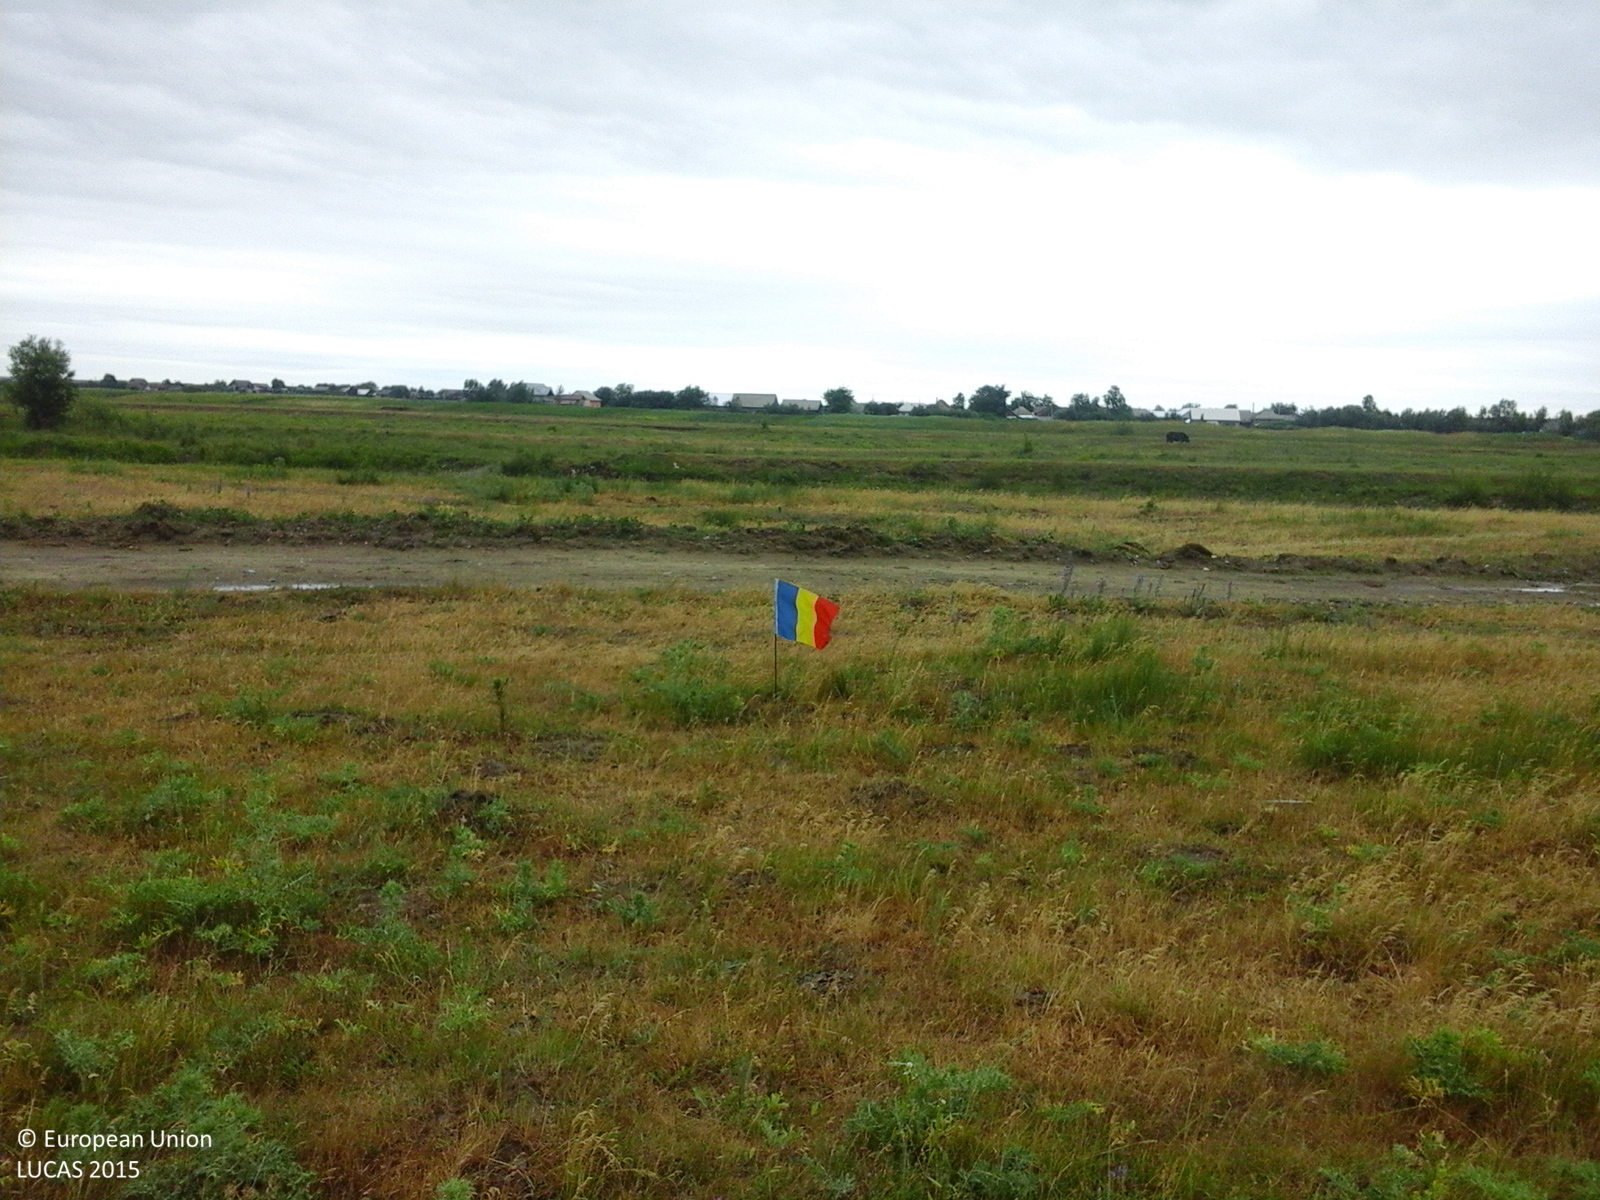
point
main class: Grassland
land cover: Grassland without tree/shrub cover
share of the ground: > 75 %
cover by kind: herbaceous plants 100 %
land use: Agriculture (excluding fallow land and kitchen gardens)
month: June
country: RO
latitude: 47.4207
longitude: 26.1851
